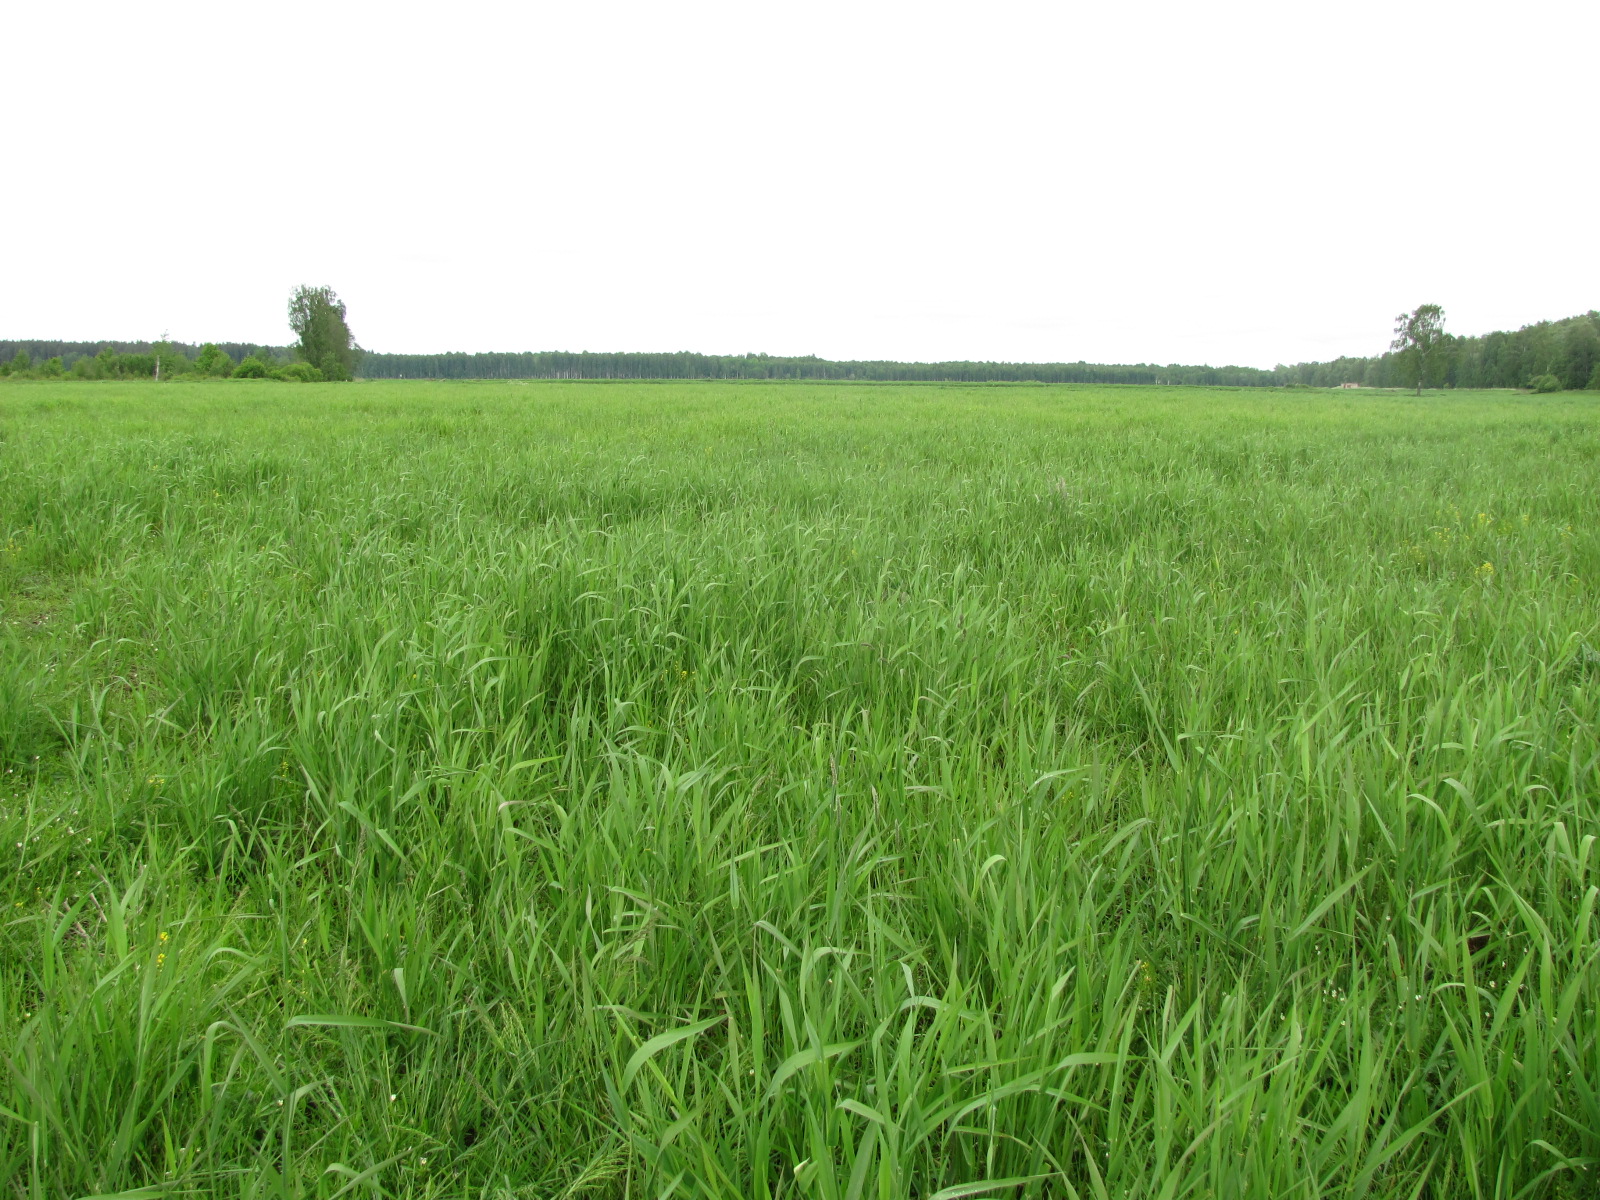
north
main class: Grassland
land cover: Grassland without tree/shrub cover
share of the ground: > 75 %
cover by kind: herbaceous plants 100 %
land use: Agriculture (excluding fallow land and kitchen gardens)
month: June
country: LV
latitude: 56.5912
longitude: 24.4408
